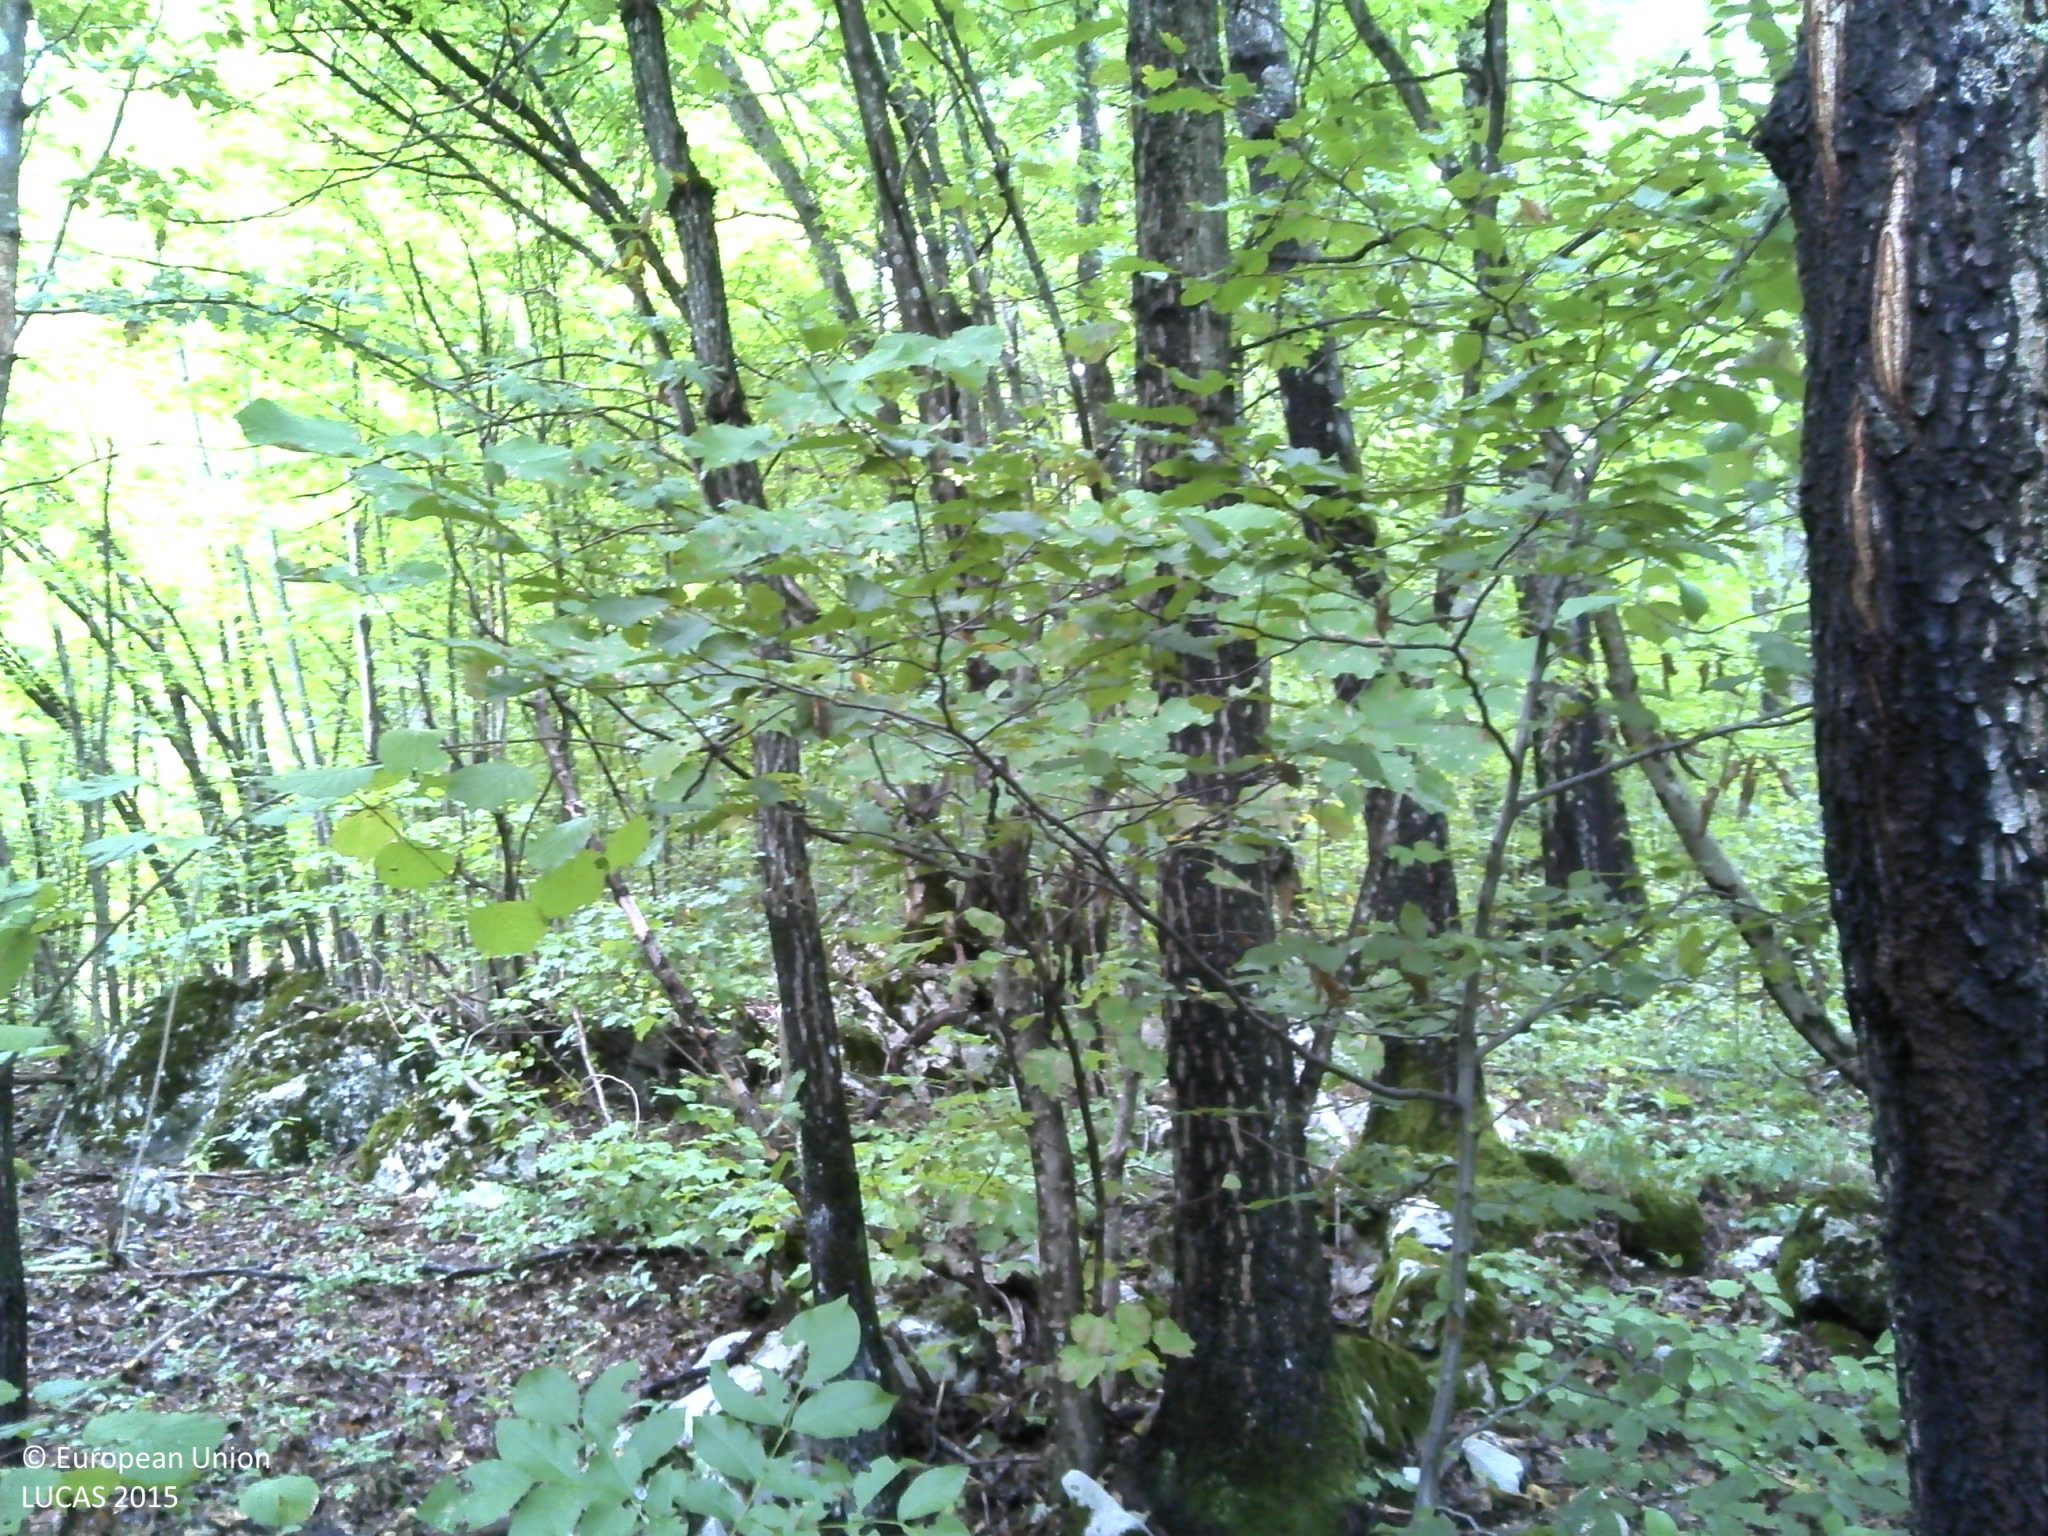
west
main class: Woodland
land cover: Broadleaved woodland
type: acidophilous oak and oak-birch forest
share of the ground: > 75 %
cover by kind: broadleaved forest trees 100 %
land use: Forestry
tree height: > 5 m
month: September
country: HR
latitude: 45.3010
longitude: 15.2623
